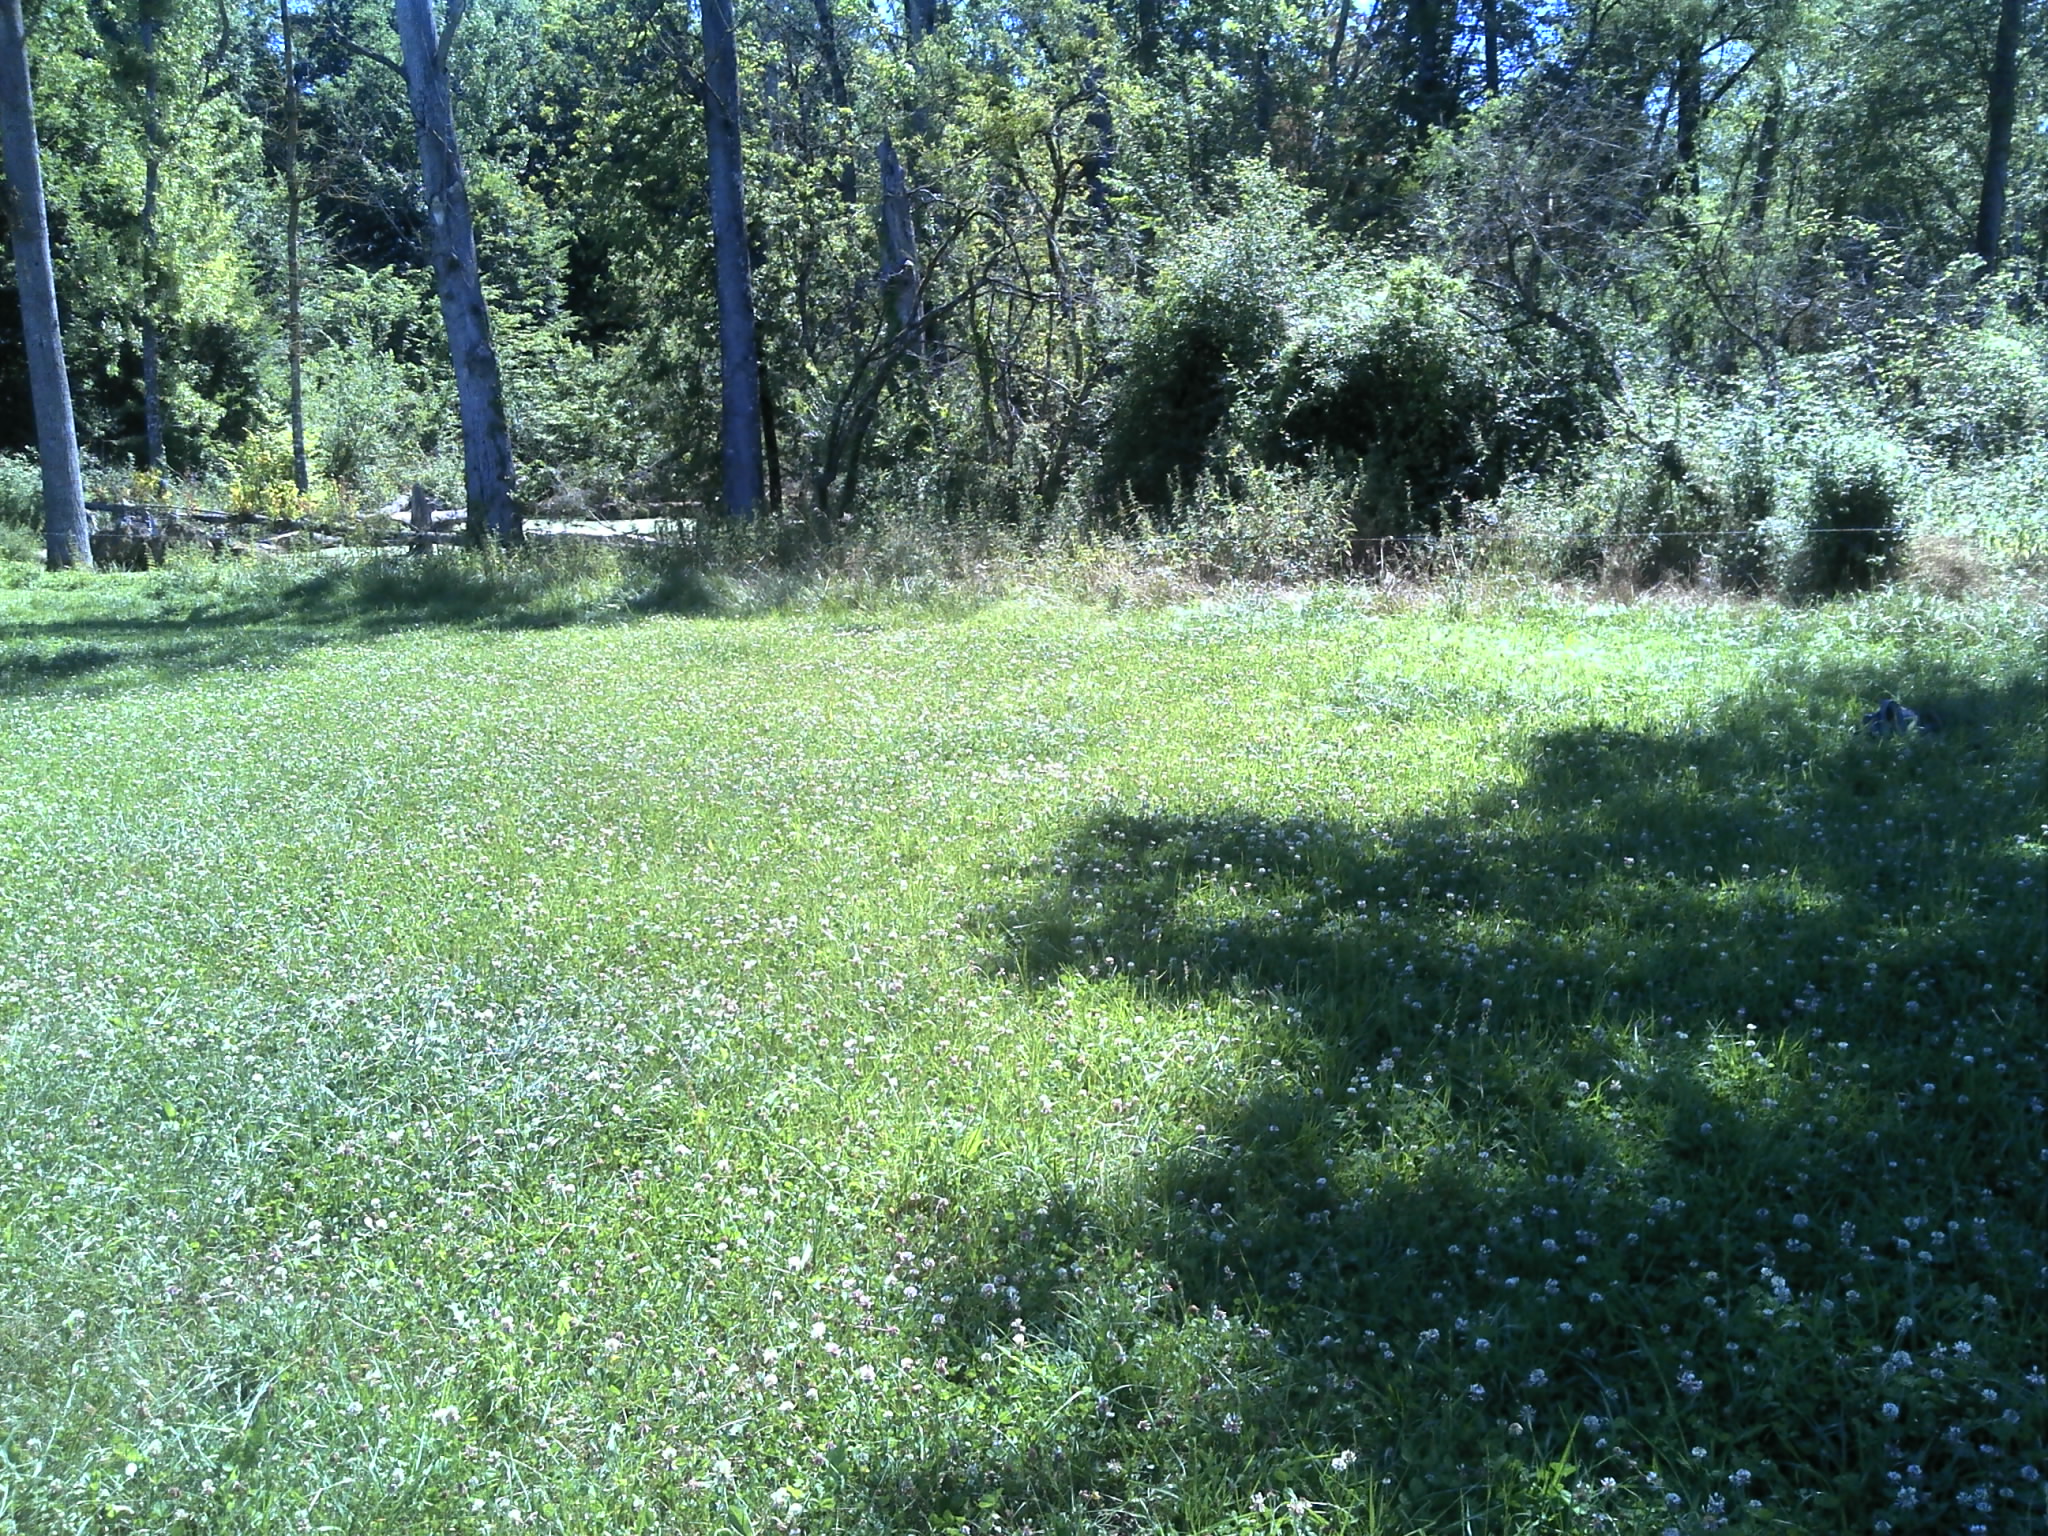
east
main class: Cropland
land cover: Clovers
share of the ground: > 75 %
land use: Agriculture (excluding fallow land and kitchen gardens)
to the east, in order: Clovers; Fences; Broadleaved woodland; Inland fresh water bodies; Broadleaved woodland; Shrubland with sparse tree cover; Ditches and canals; Grass margins; Paved roads, cycling and walking lanes; Grass margins; Ditches and canals; Managed hedges; Fences; Grassland without tree/shrub cover; Fences; Managed hedges; Maize
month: June
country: FR
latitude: 46.6532
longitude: 1.1404
